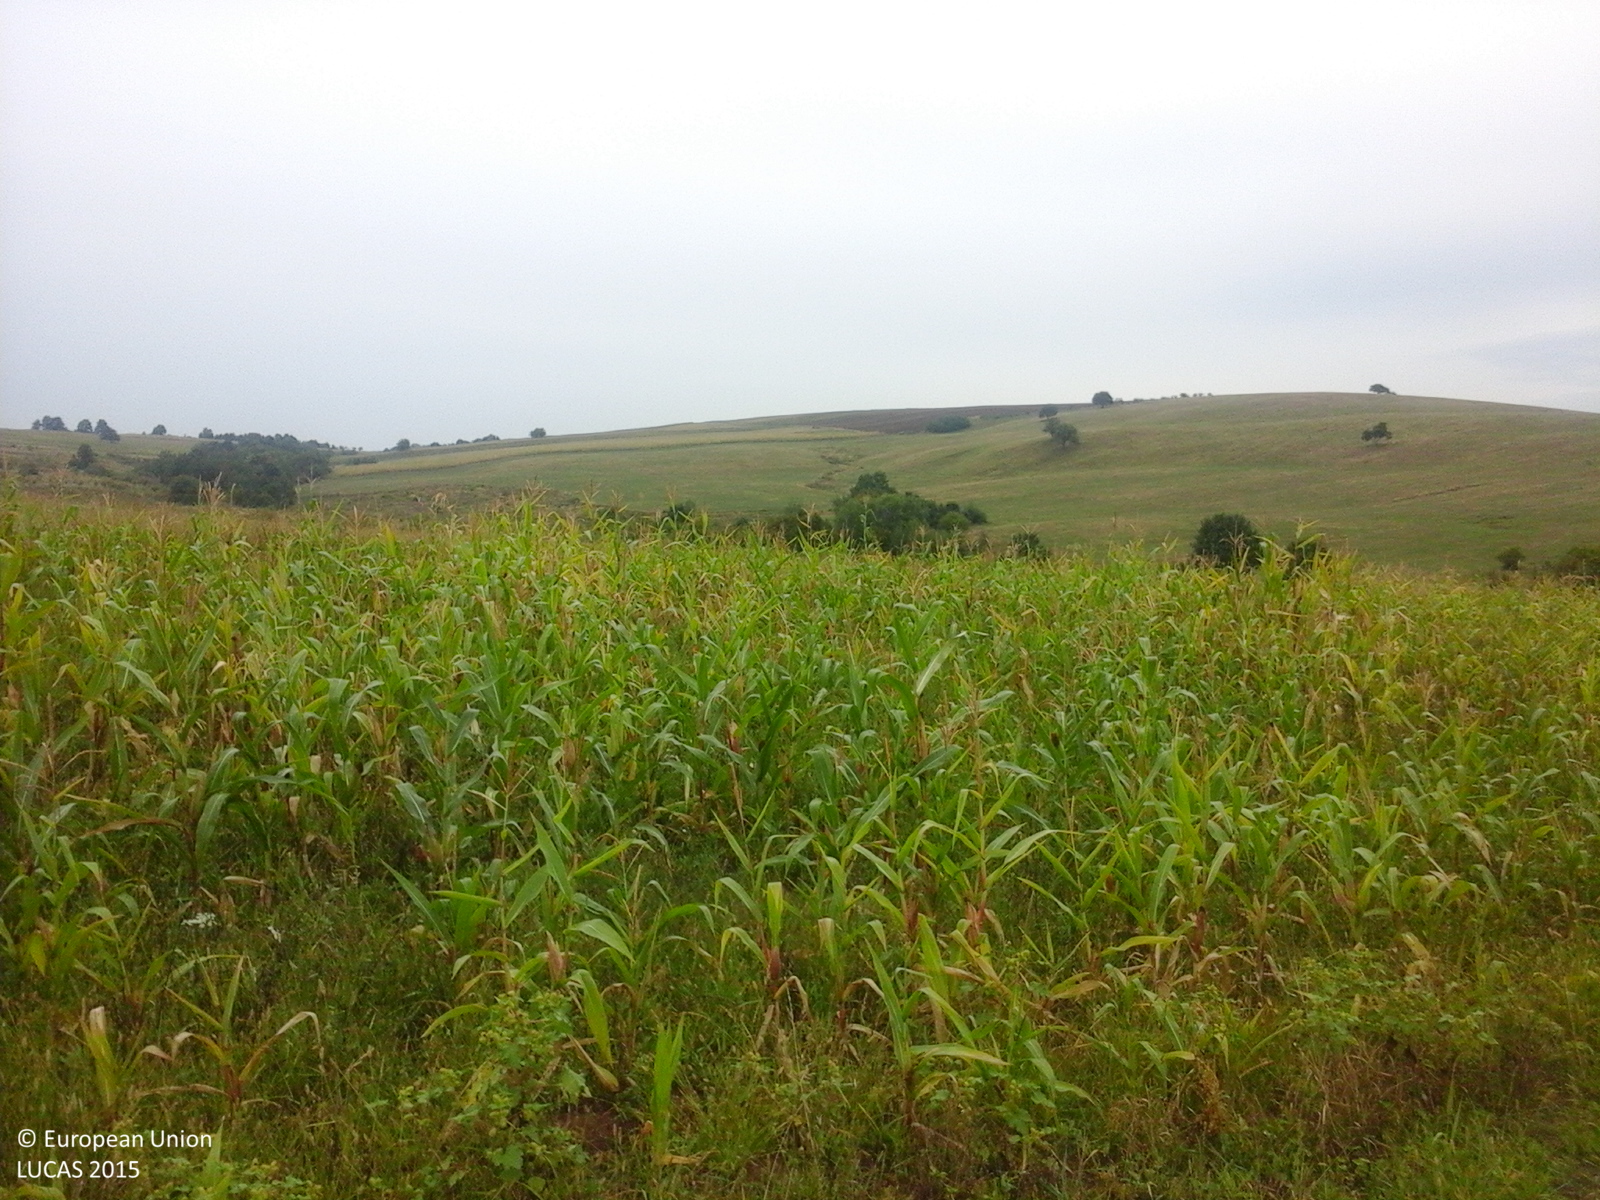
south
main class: Grassland
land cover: Grassland without tree/shrub cover
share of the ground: > 75 %
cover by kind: herbaceous plants 100 %
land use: Agriculture (excluding fallow land and kitchen gardens)
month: September
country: RO
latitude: 47.3906
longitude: 22.5768
